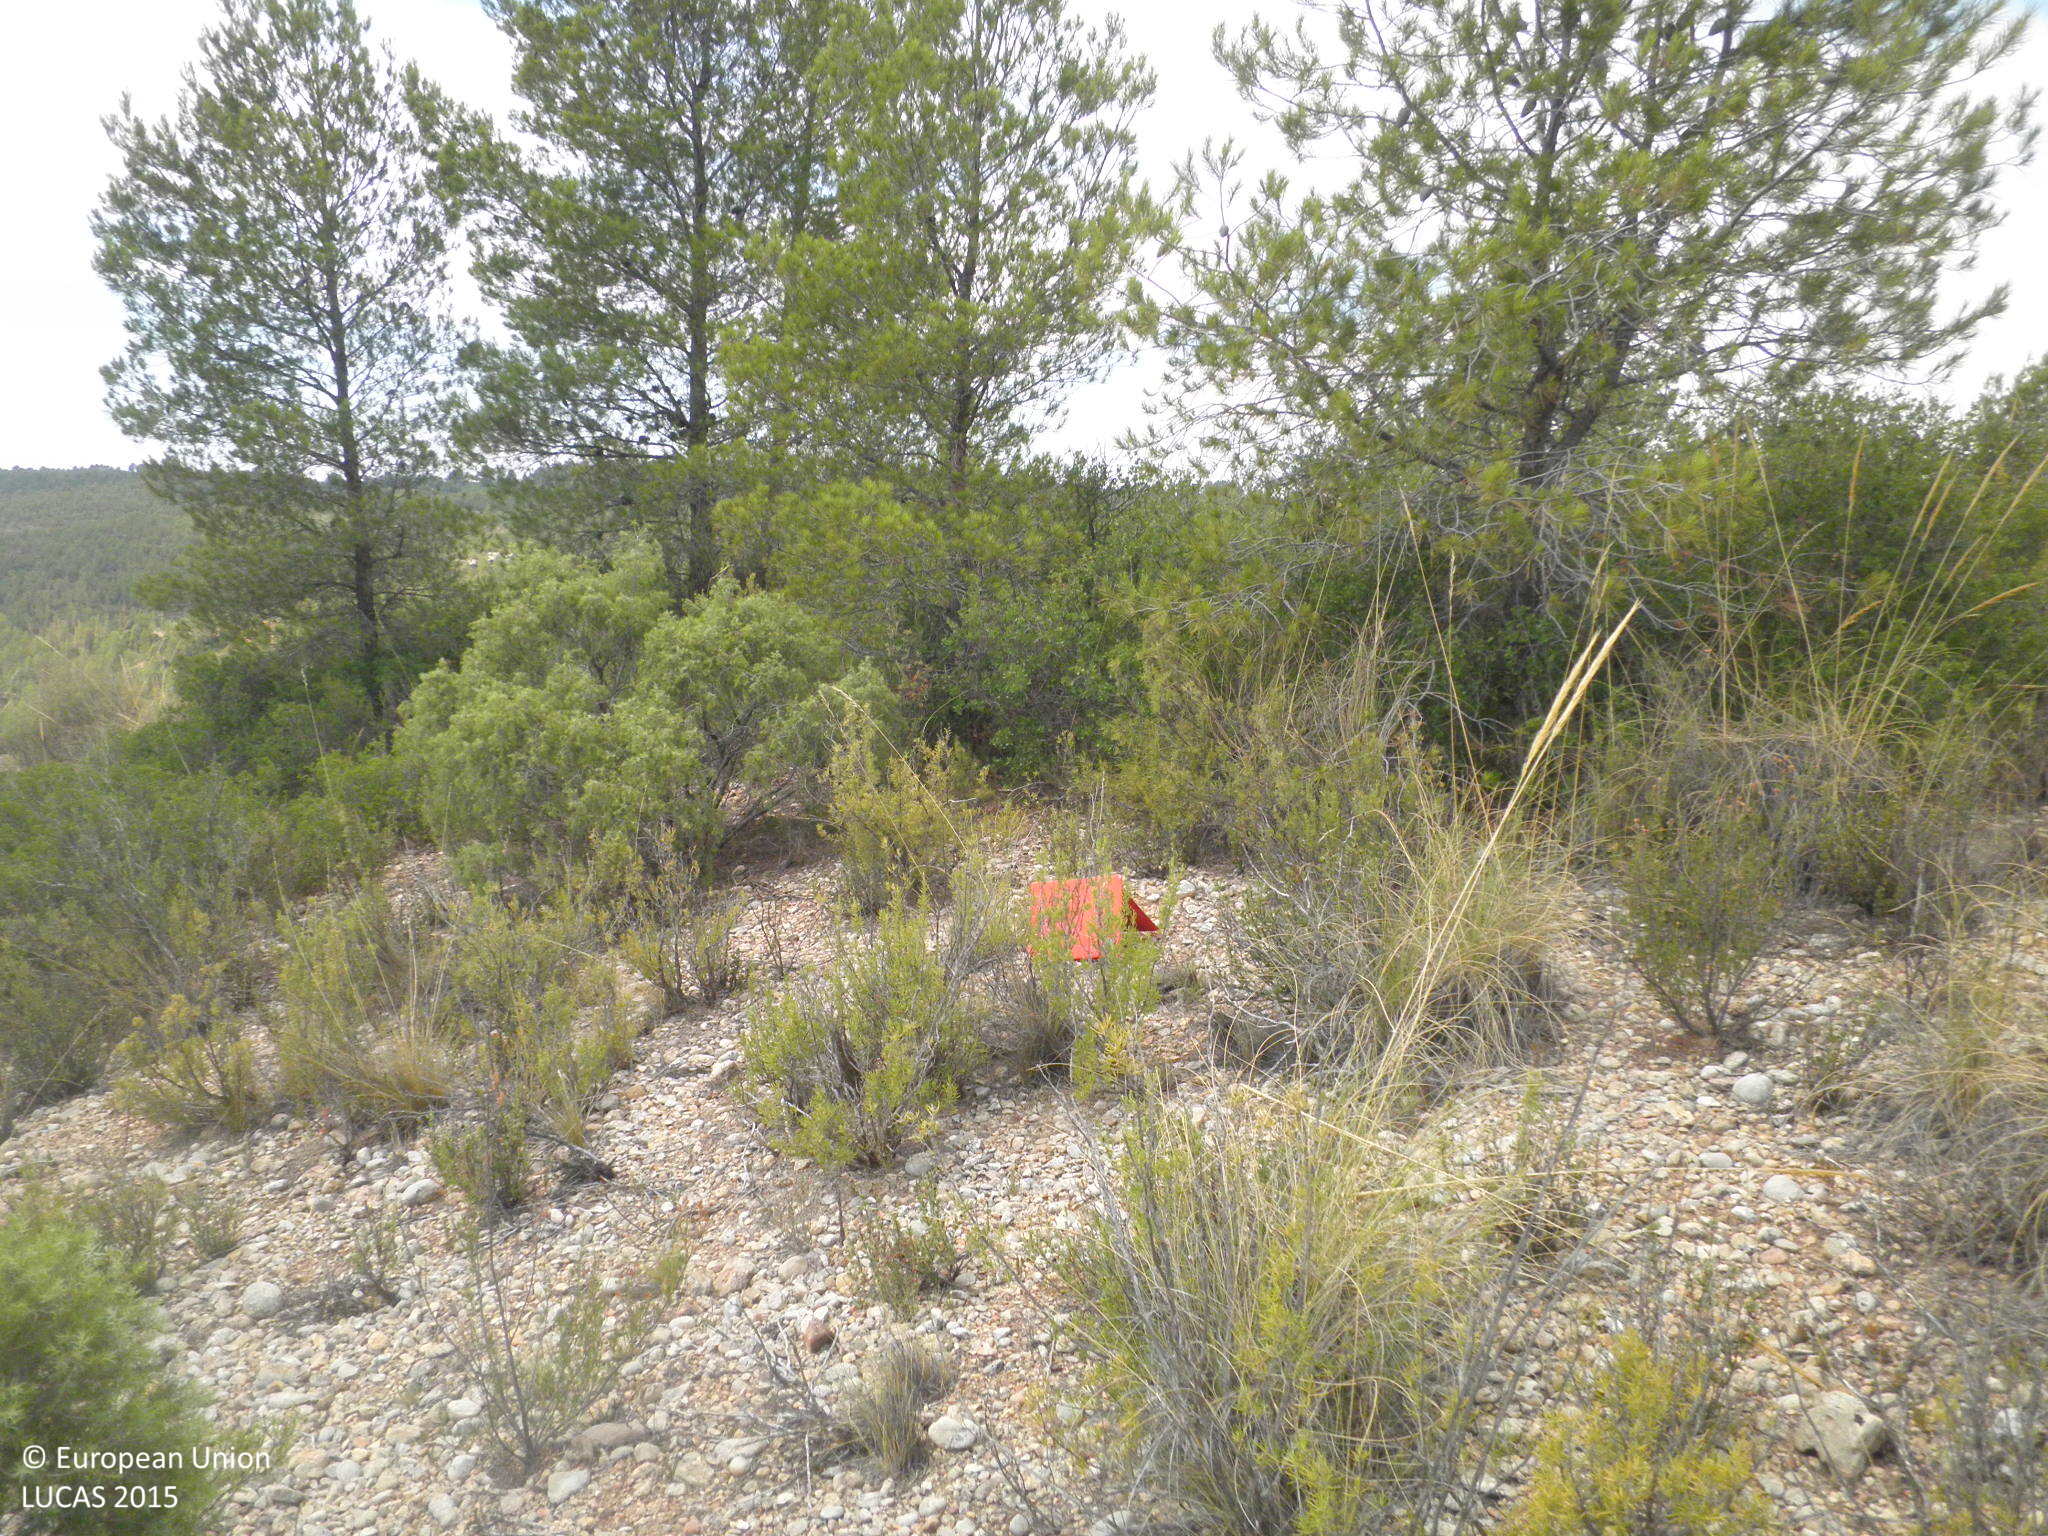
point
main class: Woodland
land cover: Pine dominated coniferous woodland
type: coniferous forest of the mediterranean region
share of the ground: 10 - 25 %
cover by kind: unconsolidated bare surface 45 %, shrubs 40 %, coniferous forest trees 10 %, herbaceous plants 5 %
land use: Semi-natural and natural areas not in use
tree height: < 5 m
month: July
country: ES
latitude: 39.5299
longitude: -1.5338
